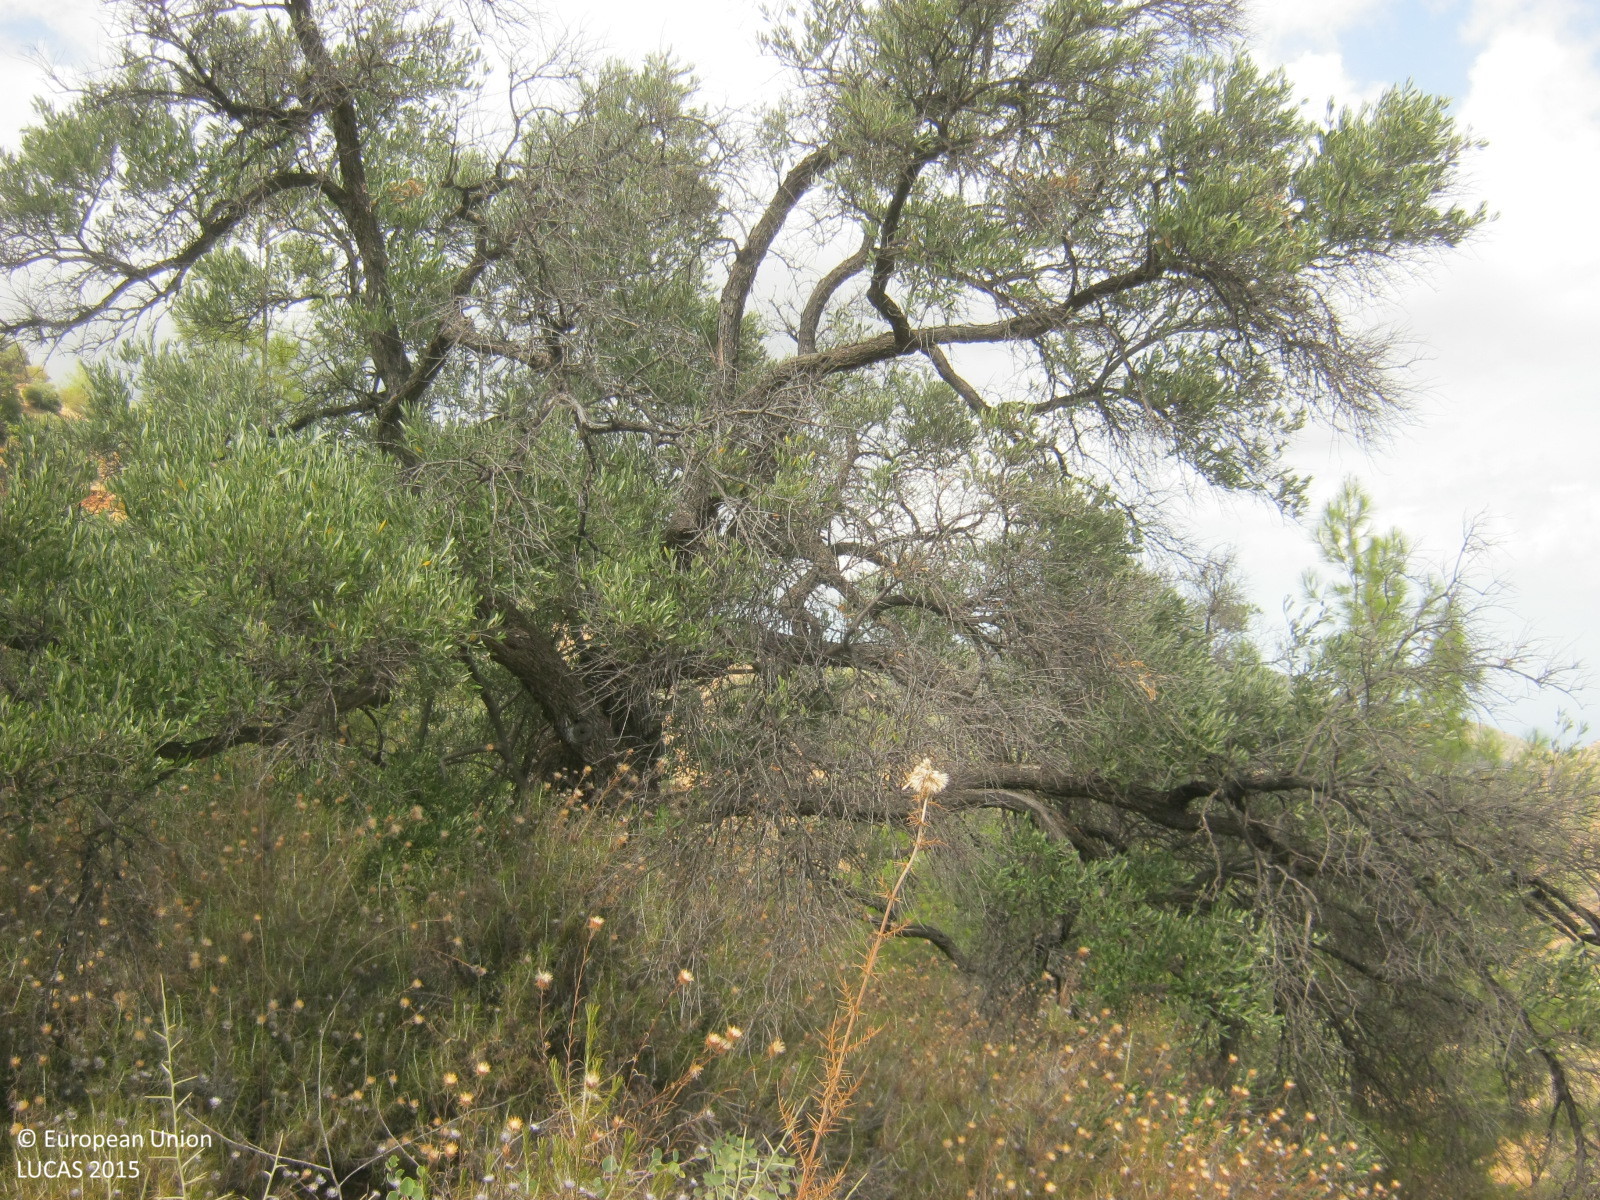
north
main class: Woodland
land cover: Other mixed woodland
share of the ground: 25 - 50 %
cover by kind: shrubs 30 %, herbaceous plants 30 %, broadleaved forest trees 25 %, coniferous forest trees 15 %
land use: Semi-natural and natural areas not in use
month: September
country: CY
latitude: 35.0265
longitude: 32.8228
